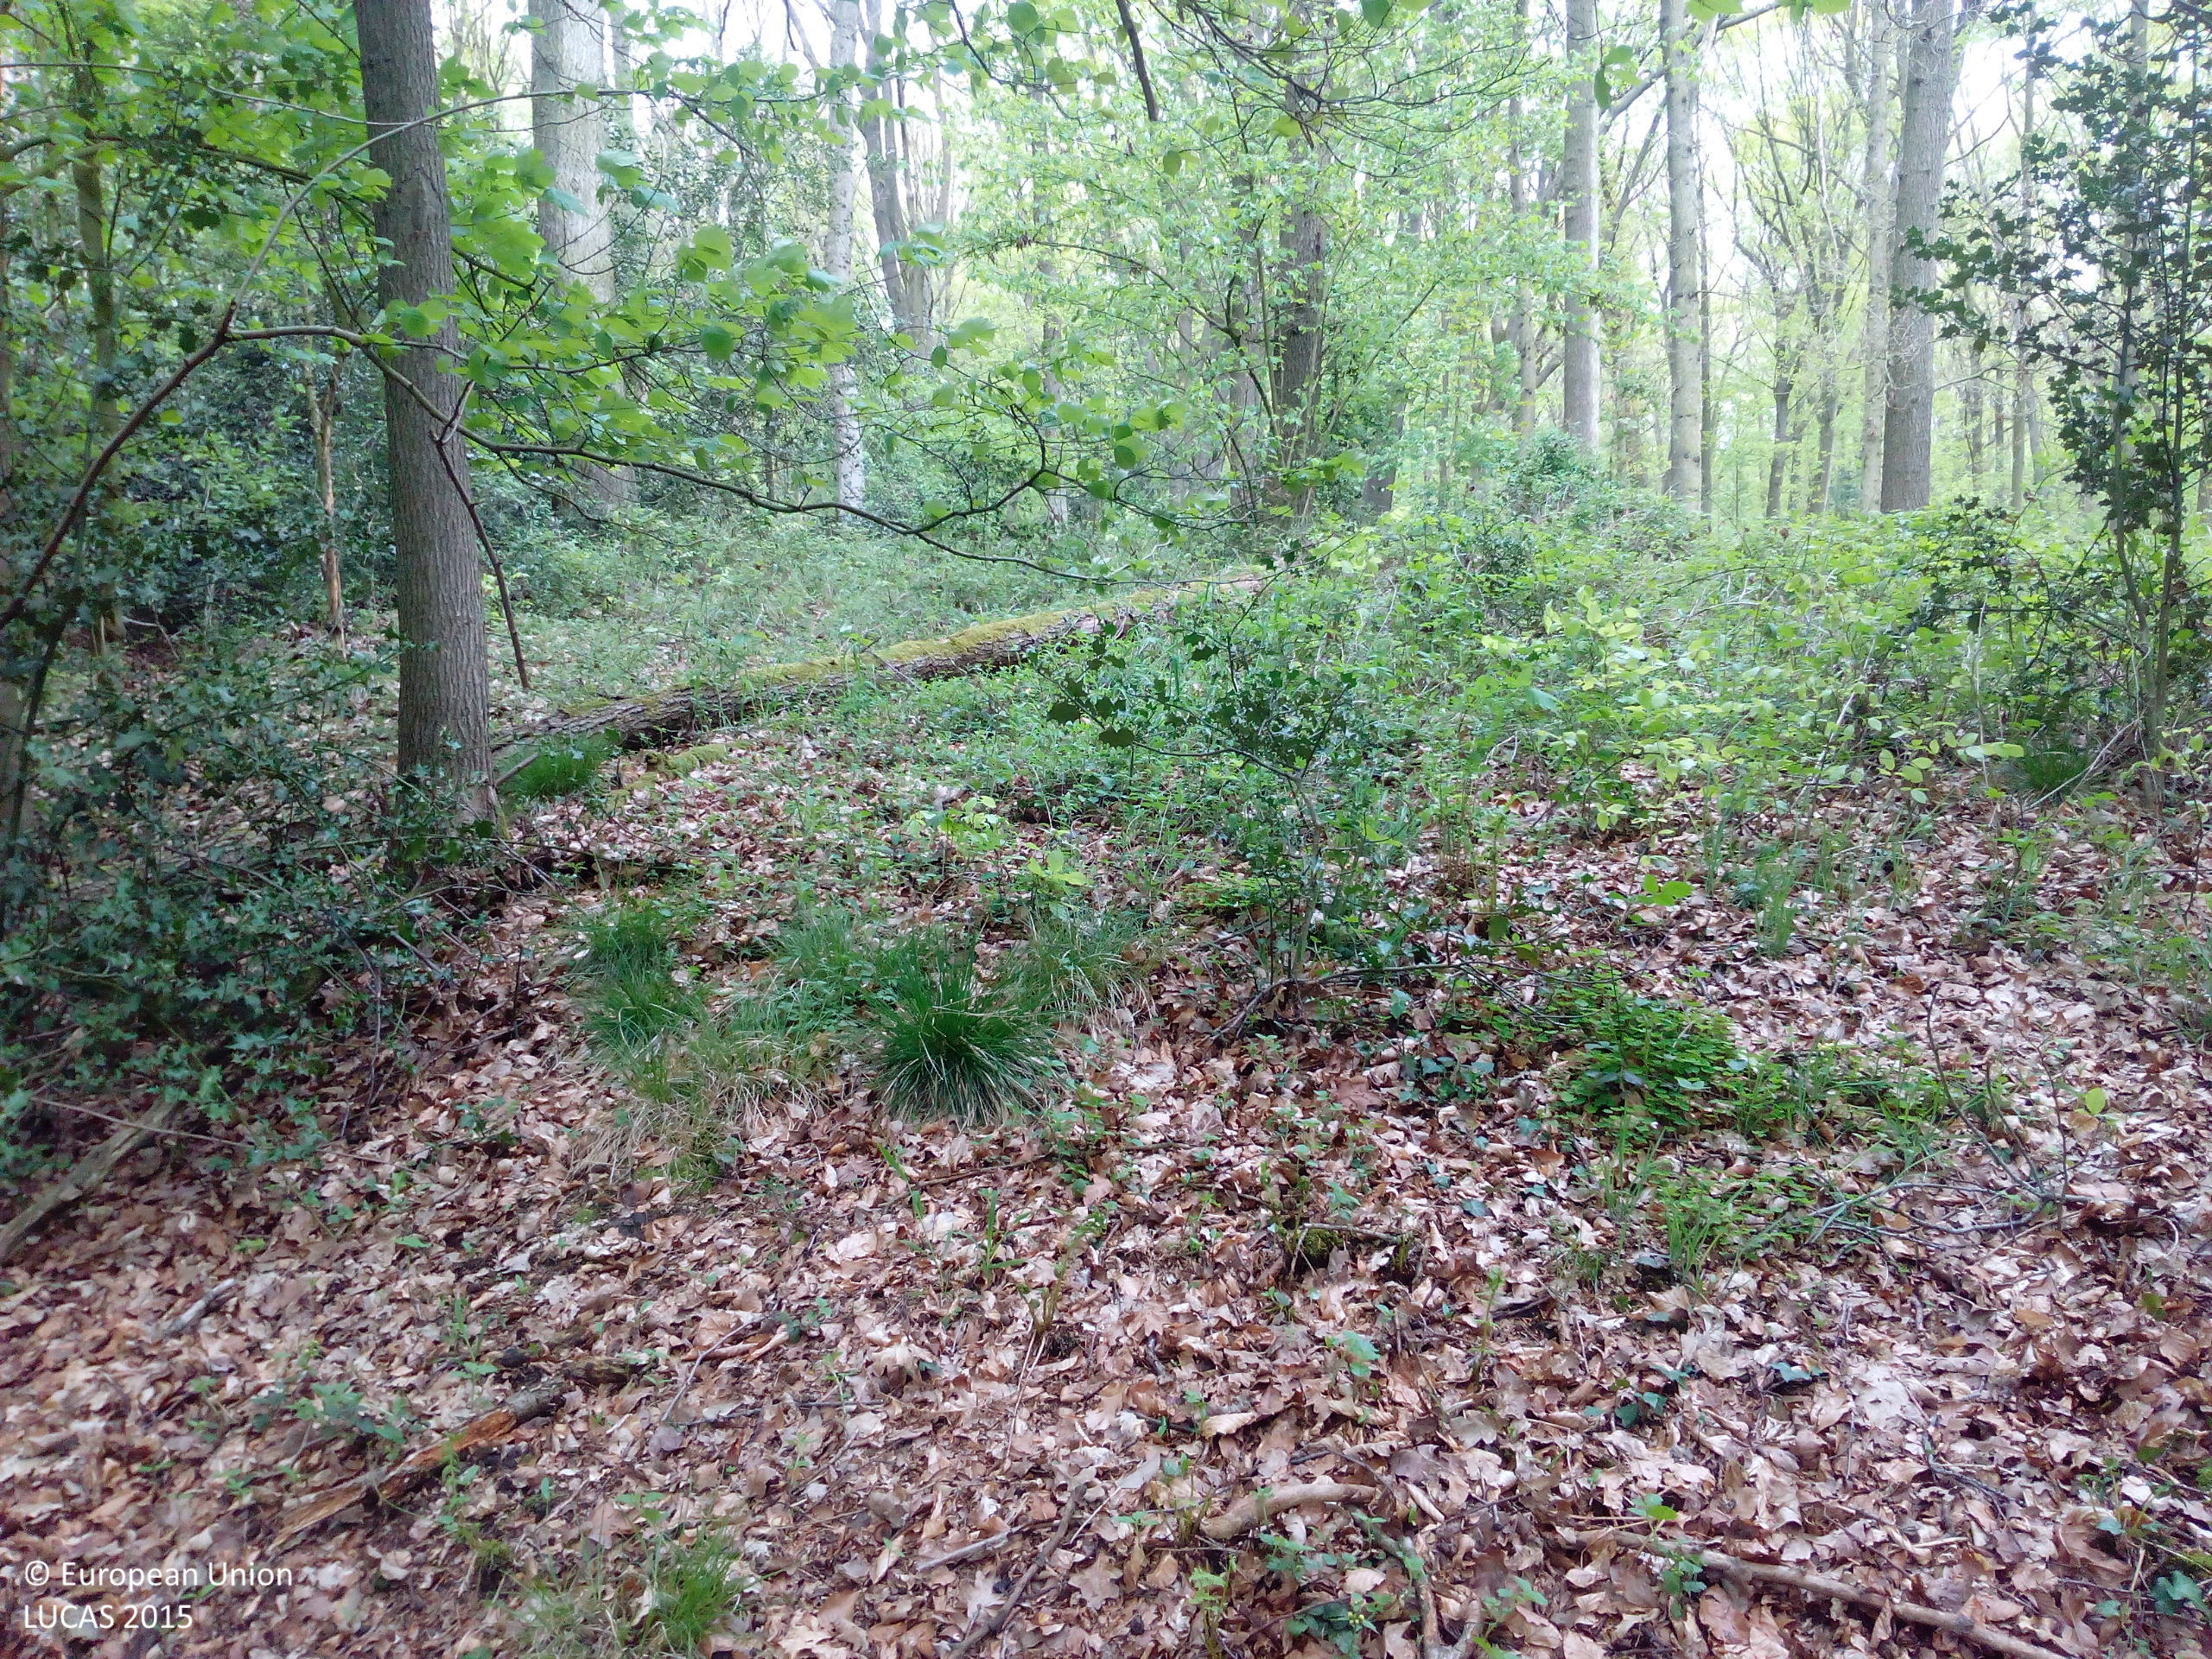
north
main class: Woodland
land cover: Broadleaved woodland
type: mesophytic deciduous forest
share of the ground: > 75 %
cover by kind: broadleaved forest trees 90 %, shrubs 5 %, unconsolidated bare surface 5 %
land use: Forestry
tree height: > 5 m
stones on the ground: < 10 %
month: May
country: DE
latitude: 51.6659
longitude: 7.4122
